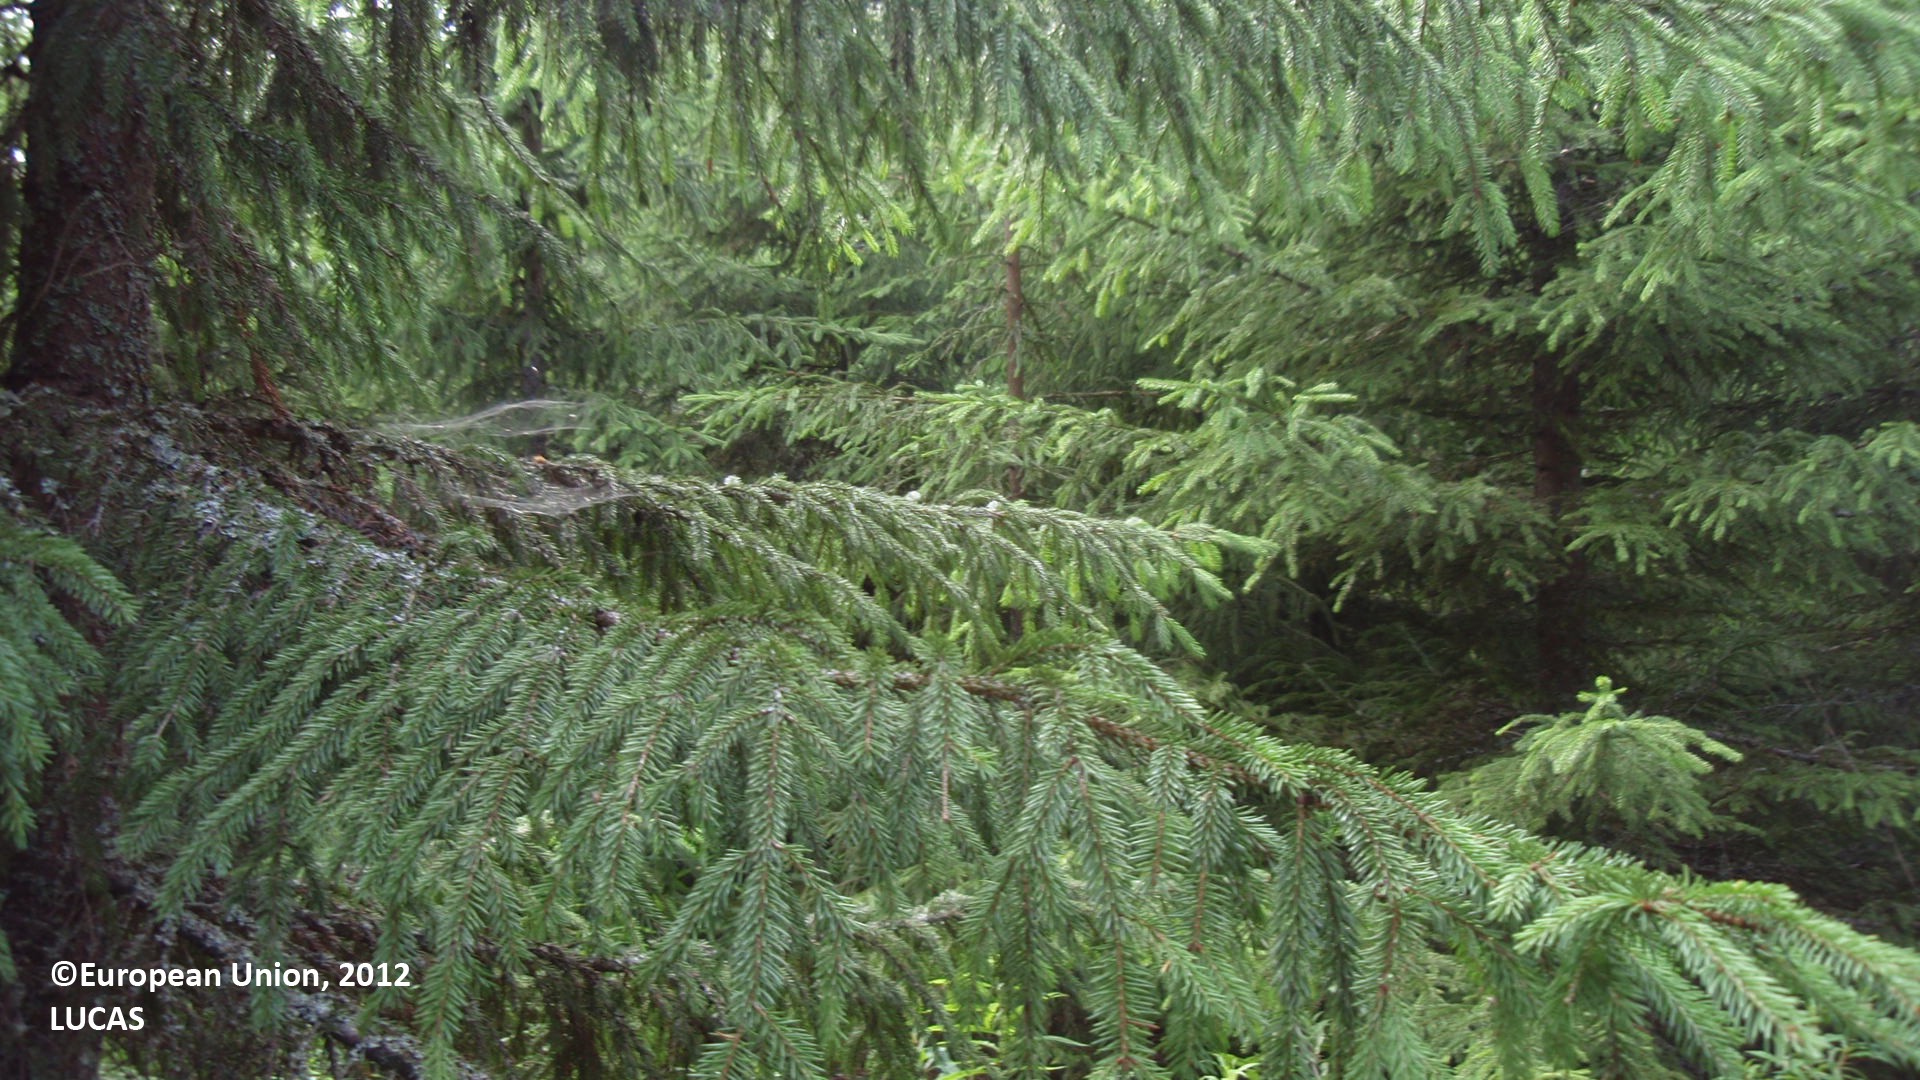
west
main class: Woodland
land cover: Spruce dominated coniferous woodland
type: boreal forest
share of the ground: > 75 %
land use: Forestry
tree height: > 5 m
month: August
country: FI
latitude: 61.0461
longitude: 26.9605
